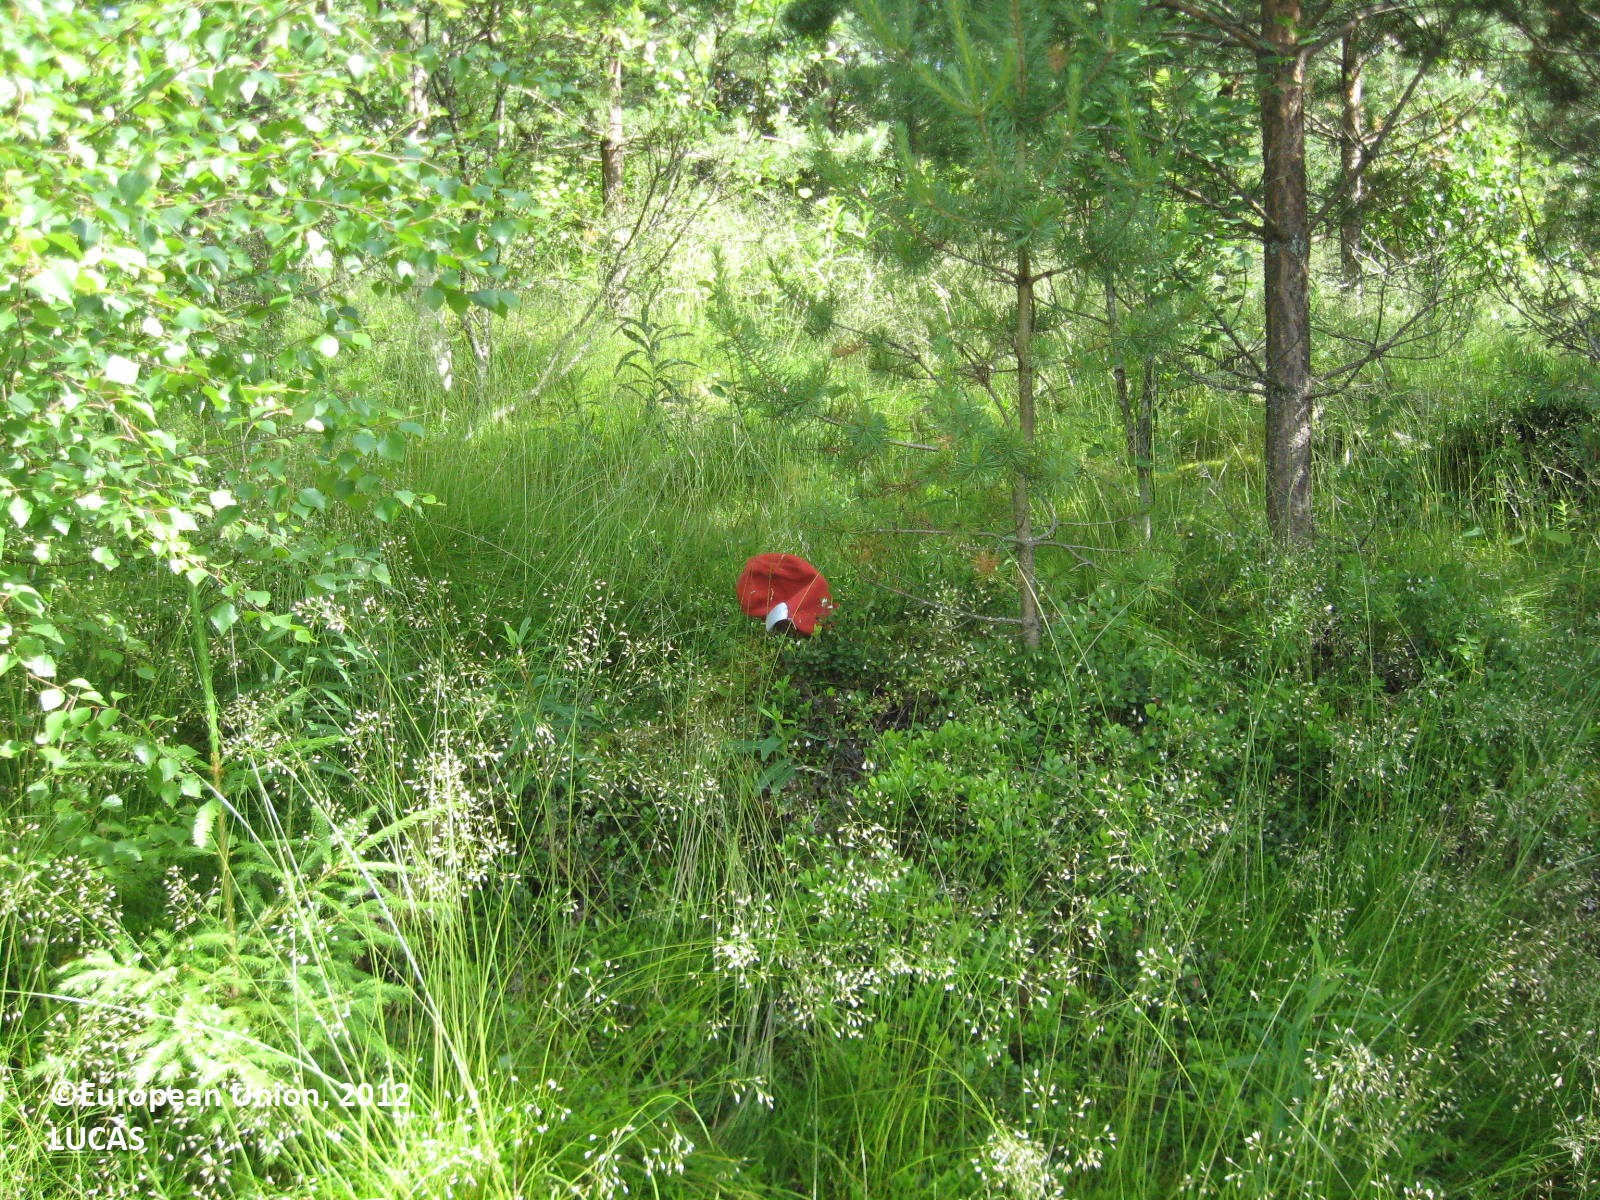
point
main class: Woodland
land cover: Other mixed woodland
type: boreal forest
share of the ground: > 75 %
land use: Forestry
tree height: > 5 m
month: July
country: FI
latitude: 62.2506
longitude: 22.3188
